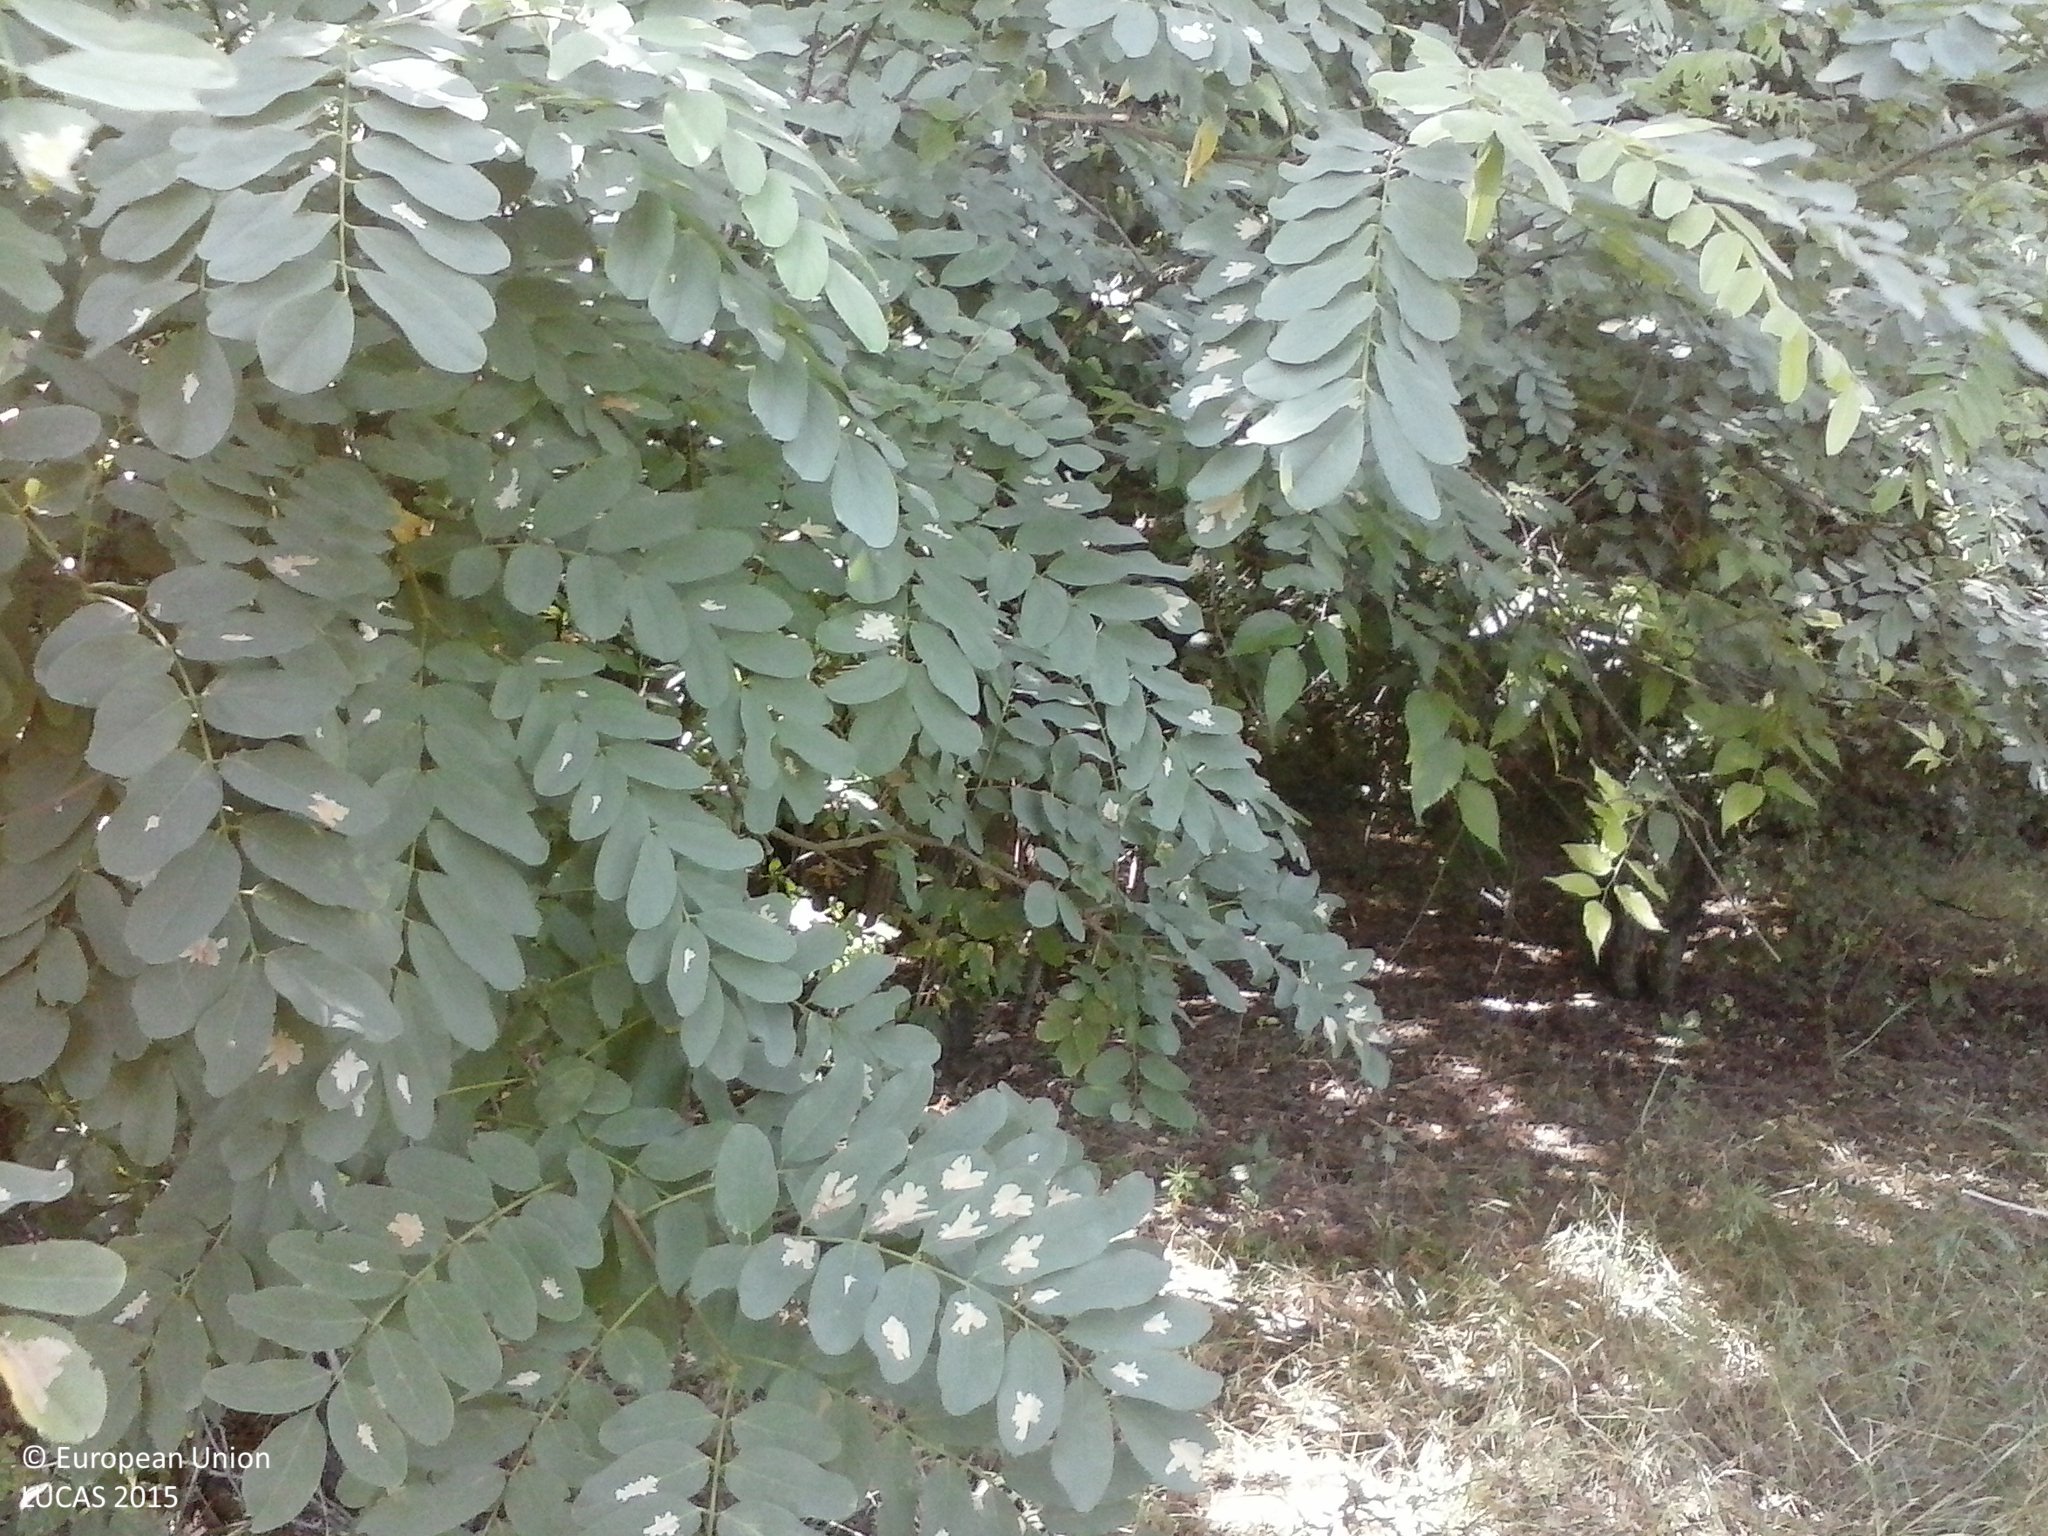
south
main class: Woodland
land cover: Broadleaved woodland
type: mesophytic deciduous forest
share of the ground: 50 - 75 %
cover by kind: broadleaved forest trees 70 %, shrubs 15 %, herbaceous plants 15 %
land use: Semi-natural and natural areas not in use
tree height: > 5 m
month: July
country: HU
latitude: 46.5705
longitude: 19.6082
